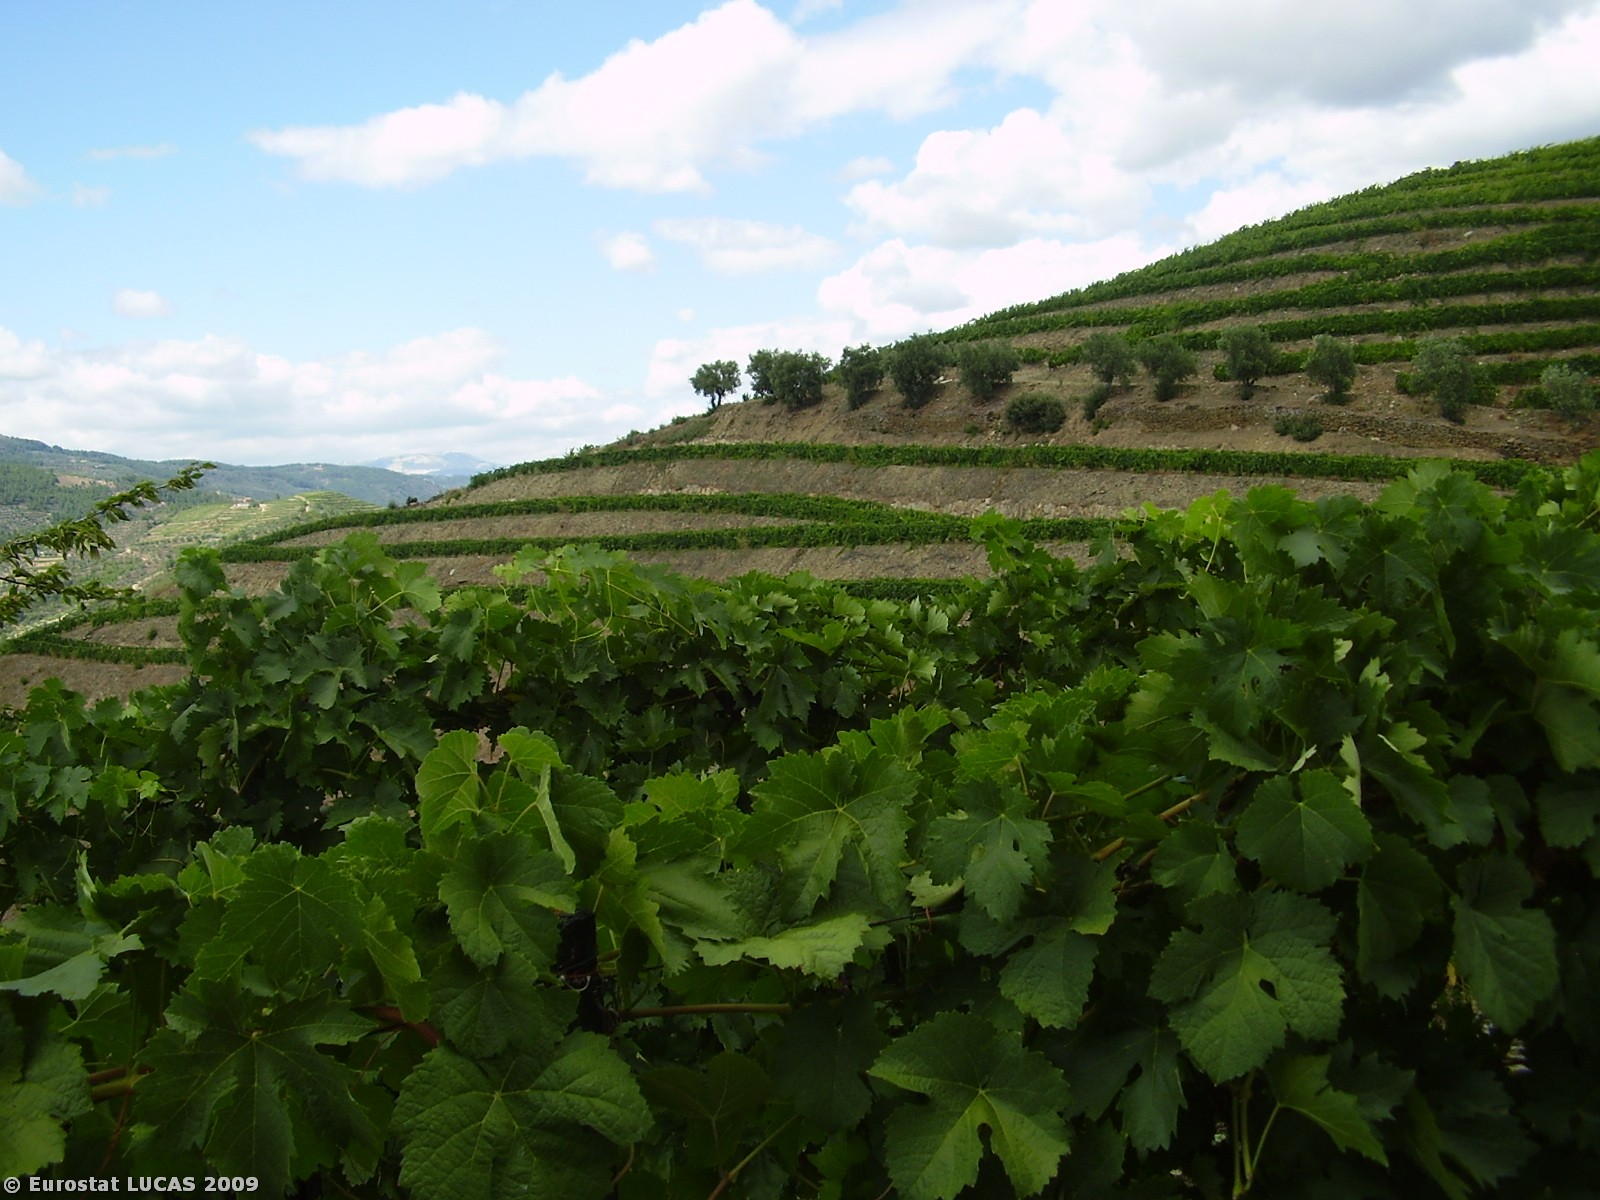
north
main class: Cropland
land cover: Vineyards
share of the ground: < 10 %
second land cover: Bare land
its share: < 10 %
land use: Agriculture (excluding fallow land and kitchen gardens)
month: July
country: PT
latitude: 41.2397
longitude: -7.5325
